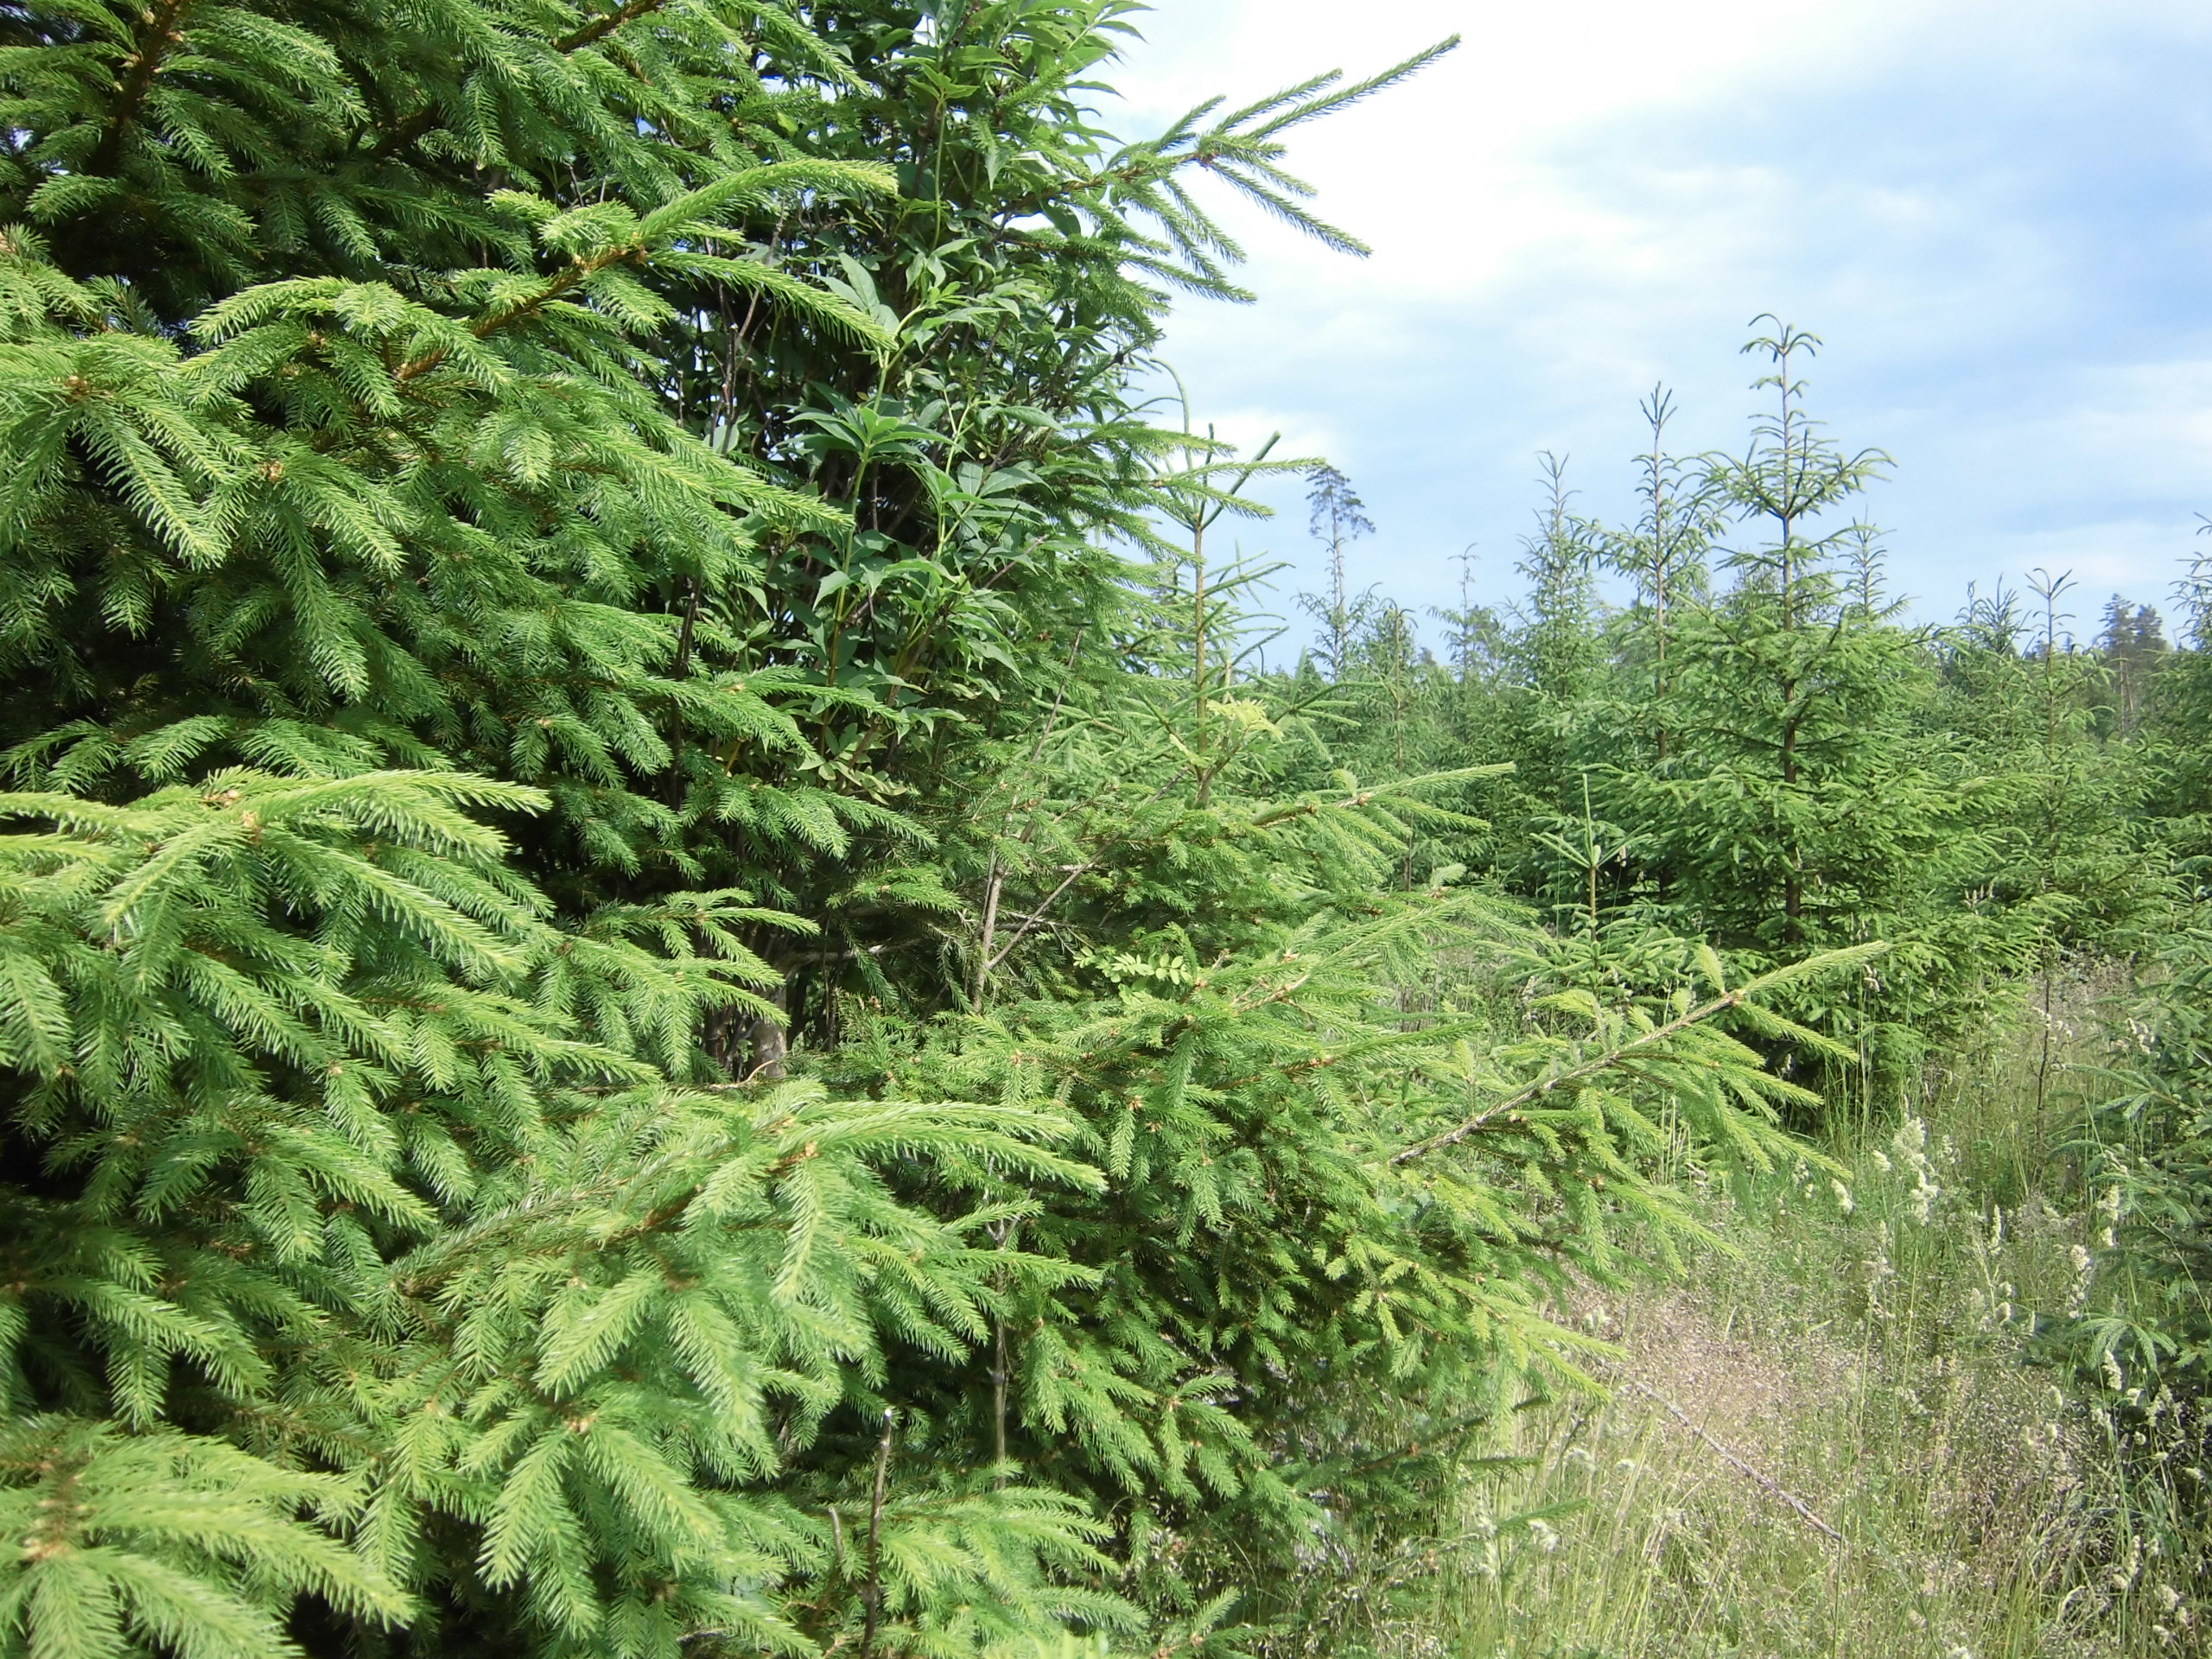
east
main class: Woodland
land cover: Spruce dominated coniferous woodland
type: boreal forest
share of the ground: 50 - 75 %
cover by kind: coniferous forest trees 50 %, herbaceous plants 35 %, broadleaved forest trees 5 %, shrubs 5 %, lichens and mosses 5 %
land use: Forestry
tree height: < 5 m
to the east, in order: Spruce dominated coniferous woodland; Dry stone walls; Spruce dominated mixed woodland; Tracks; Spruce dominated coniferous woodland; Pine dominated coniferous woodland; Tracks; Spruce dominated mixed woodland
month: July
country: SE
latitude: 57.2966
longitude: 14.5265
